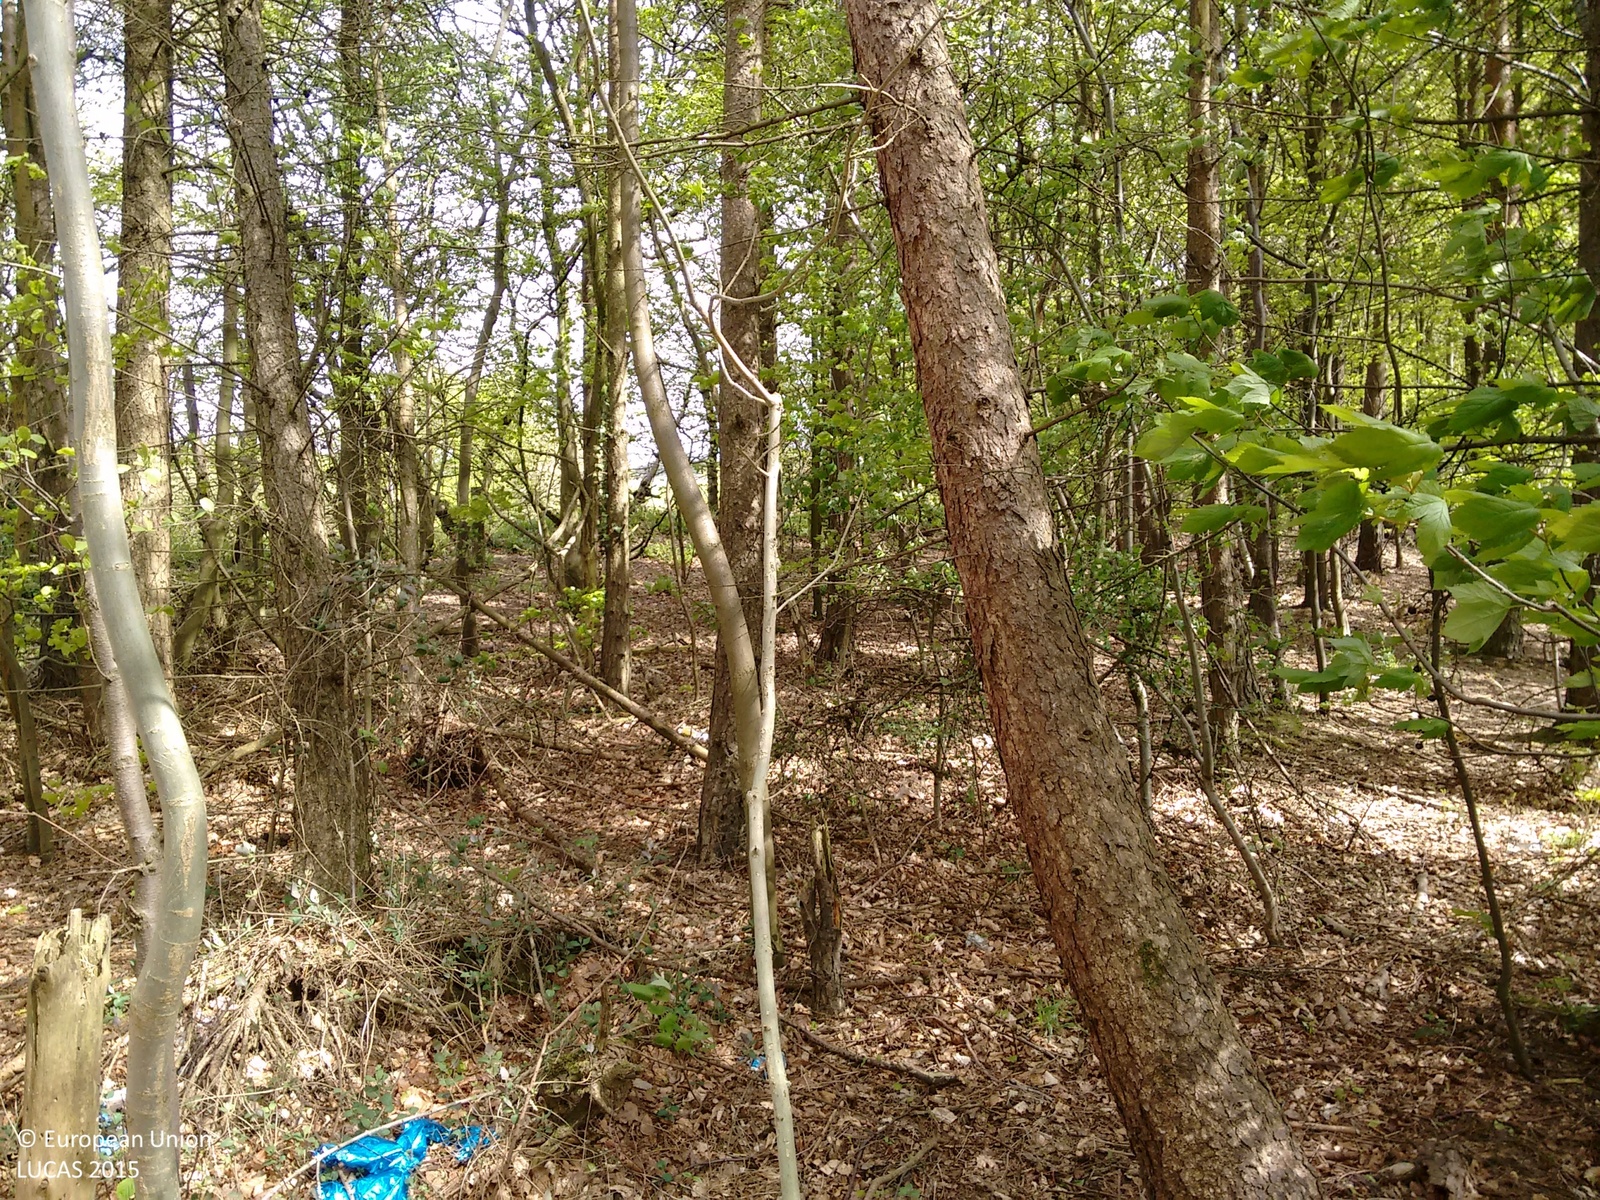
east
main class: Woodland
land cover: Broadleaved woodland
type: exotic forest
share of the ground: > 75 %
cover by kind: broadleaved forest trees 90 %, coniferous forest trees 10 %
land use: Amenities, museums, leisure
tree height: > 5 m
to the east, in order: Broadleaved woodland; Other mixed woodland; Broadleaved woodland; Inland fresh running water; Grassland with sparse tree/shrub cover; Inland fresh running water; Broadleaved woodland; Inland fresh running water; Grassland without tree/shrub cover
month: May
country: GB
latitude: 55.9695
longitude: -3.9454
